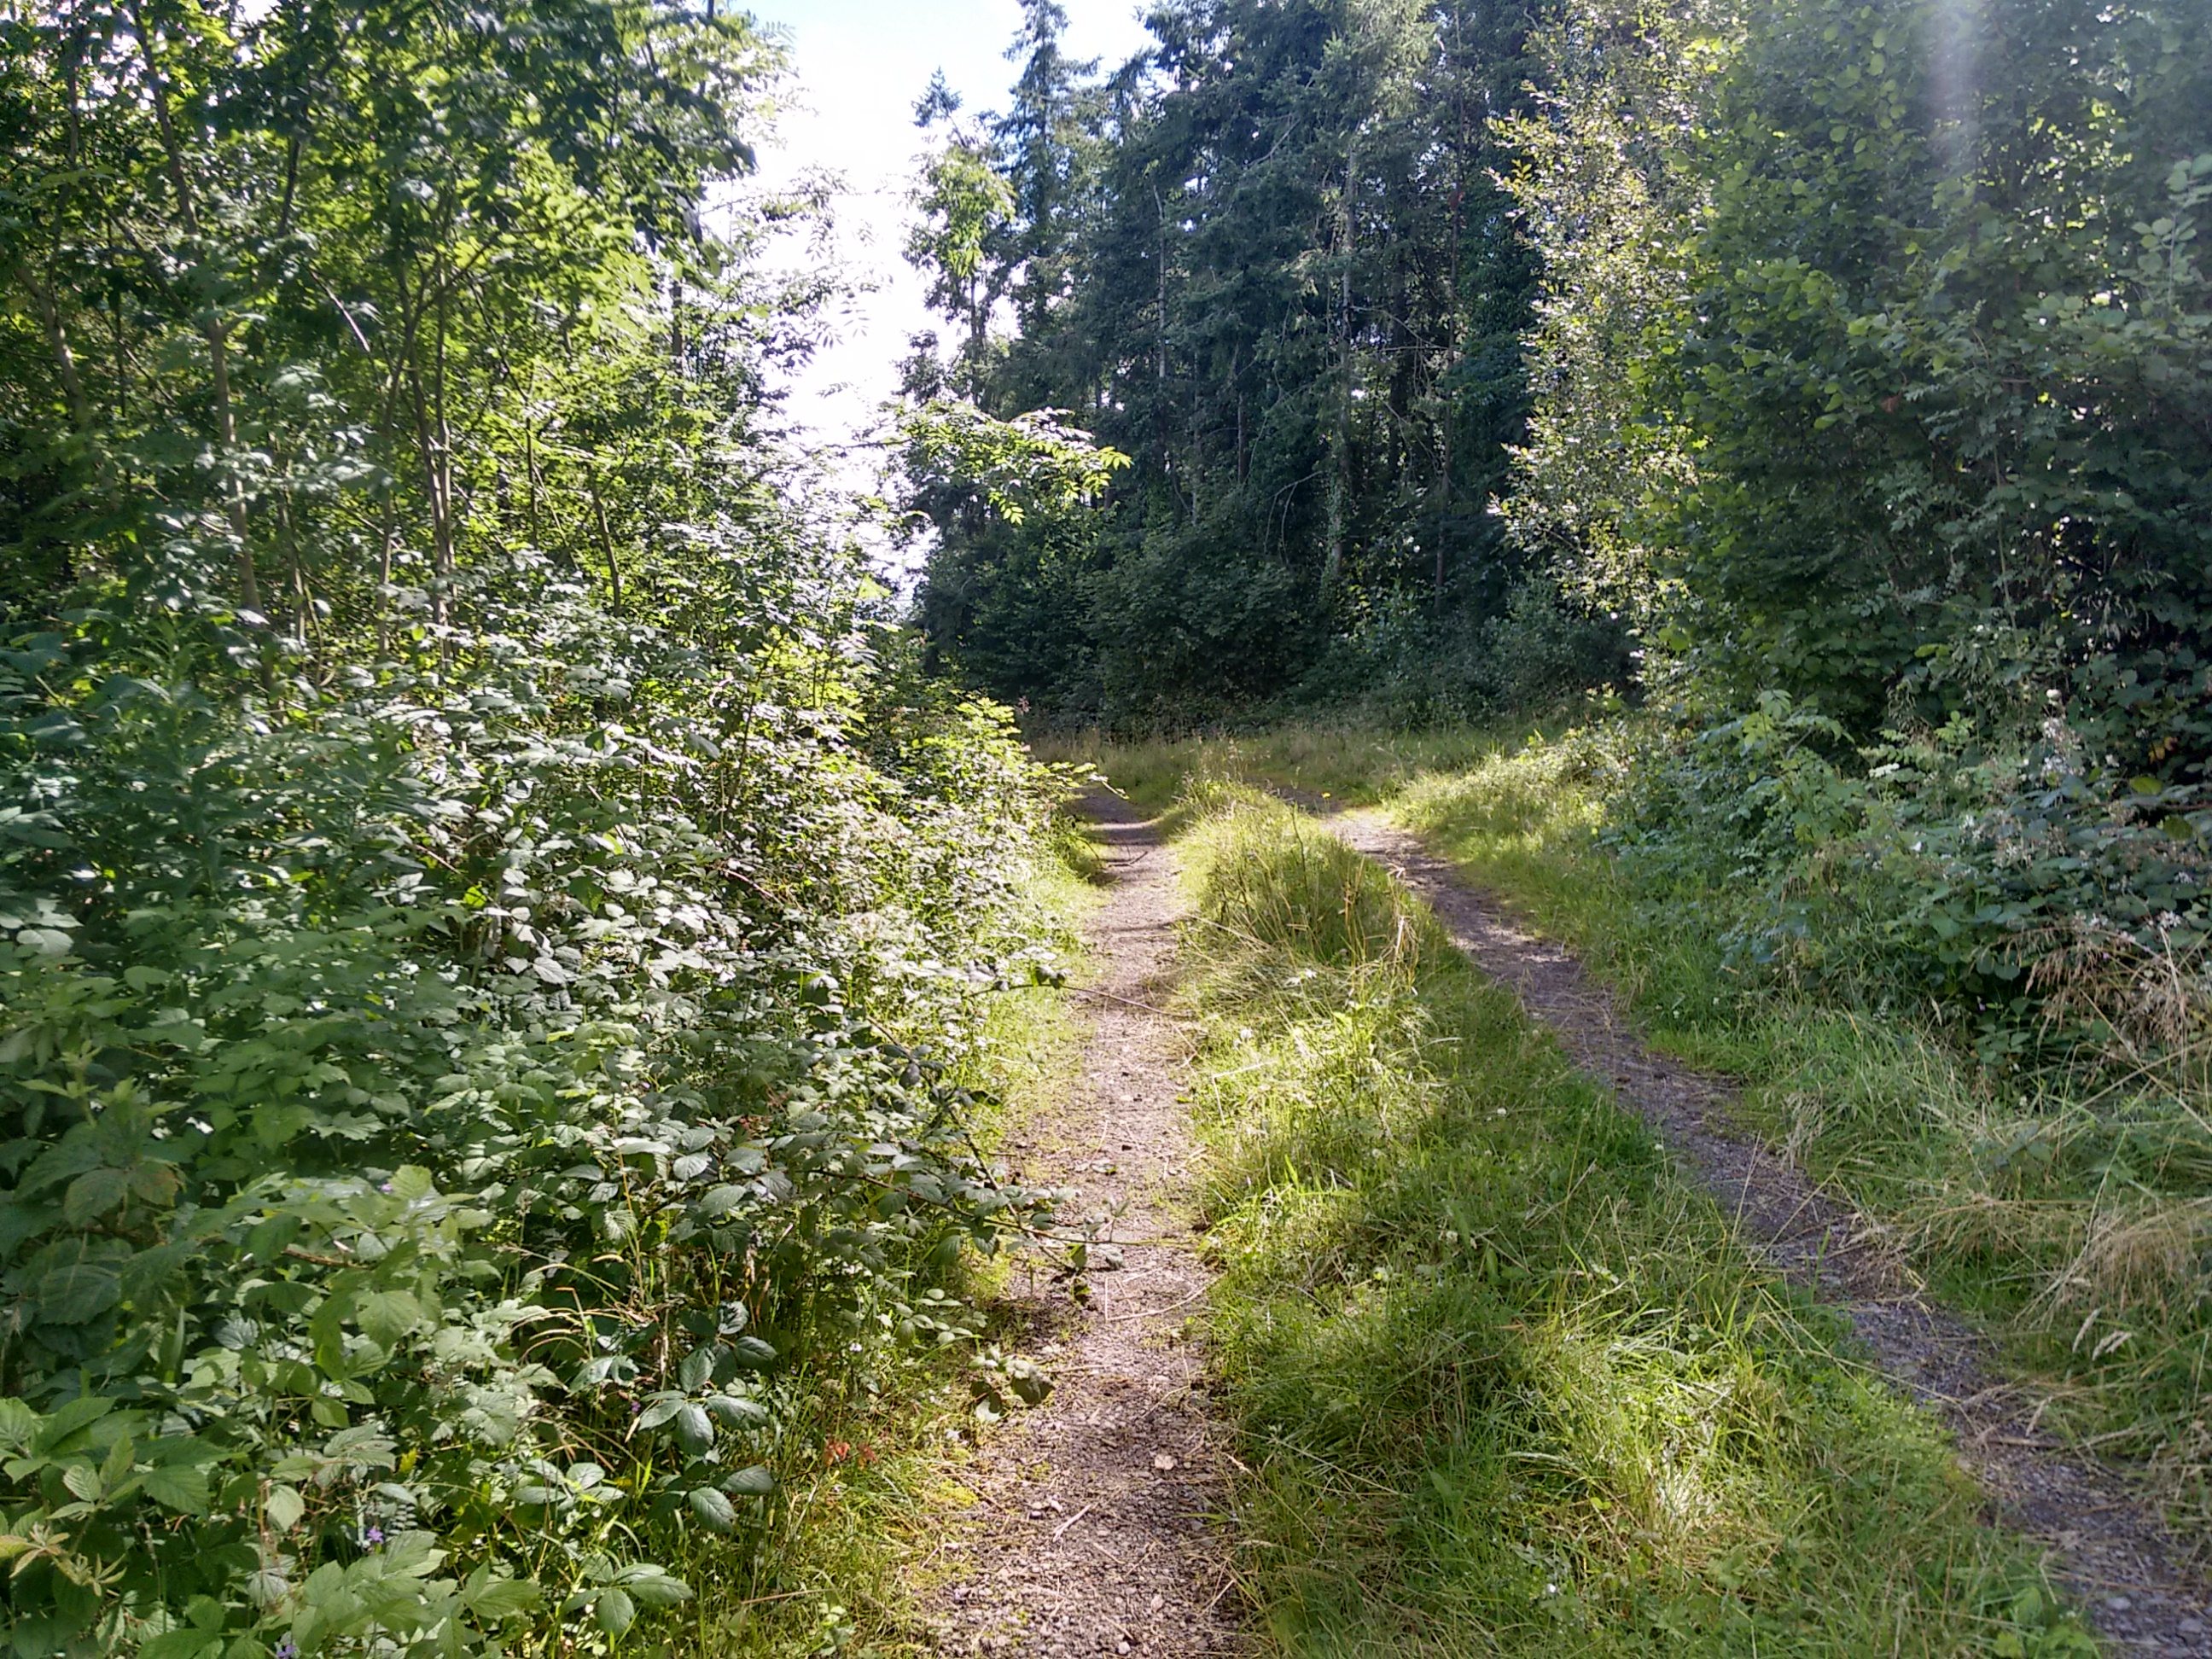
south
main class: Woodland
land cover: Other mixed woodland
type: exotic forest
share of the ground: > 75 %
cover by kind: coniferous forest trees 75 %, broadleaved forest trees 25 %
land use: Forestry
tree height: > 5 m
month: August
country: GB
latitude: 54.4764
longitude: -6.8164
